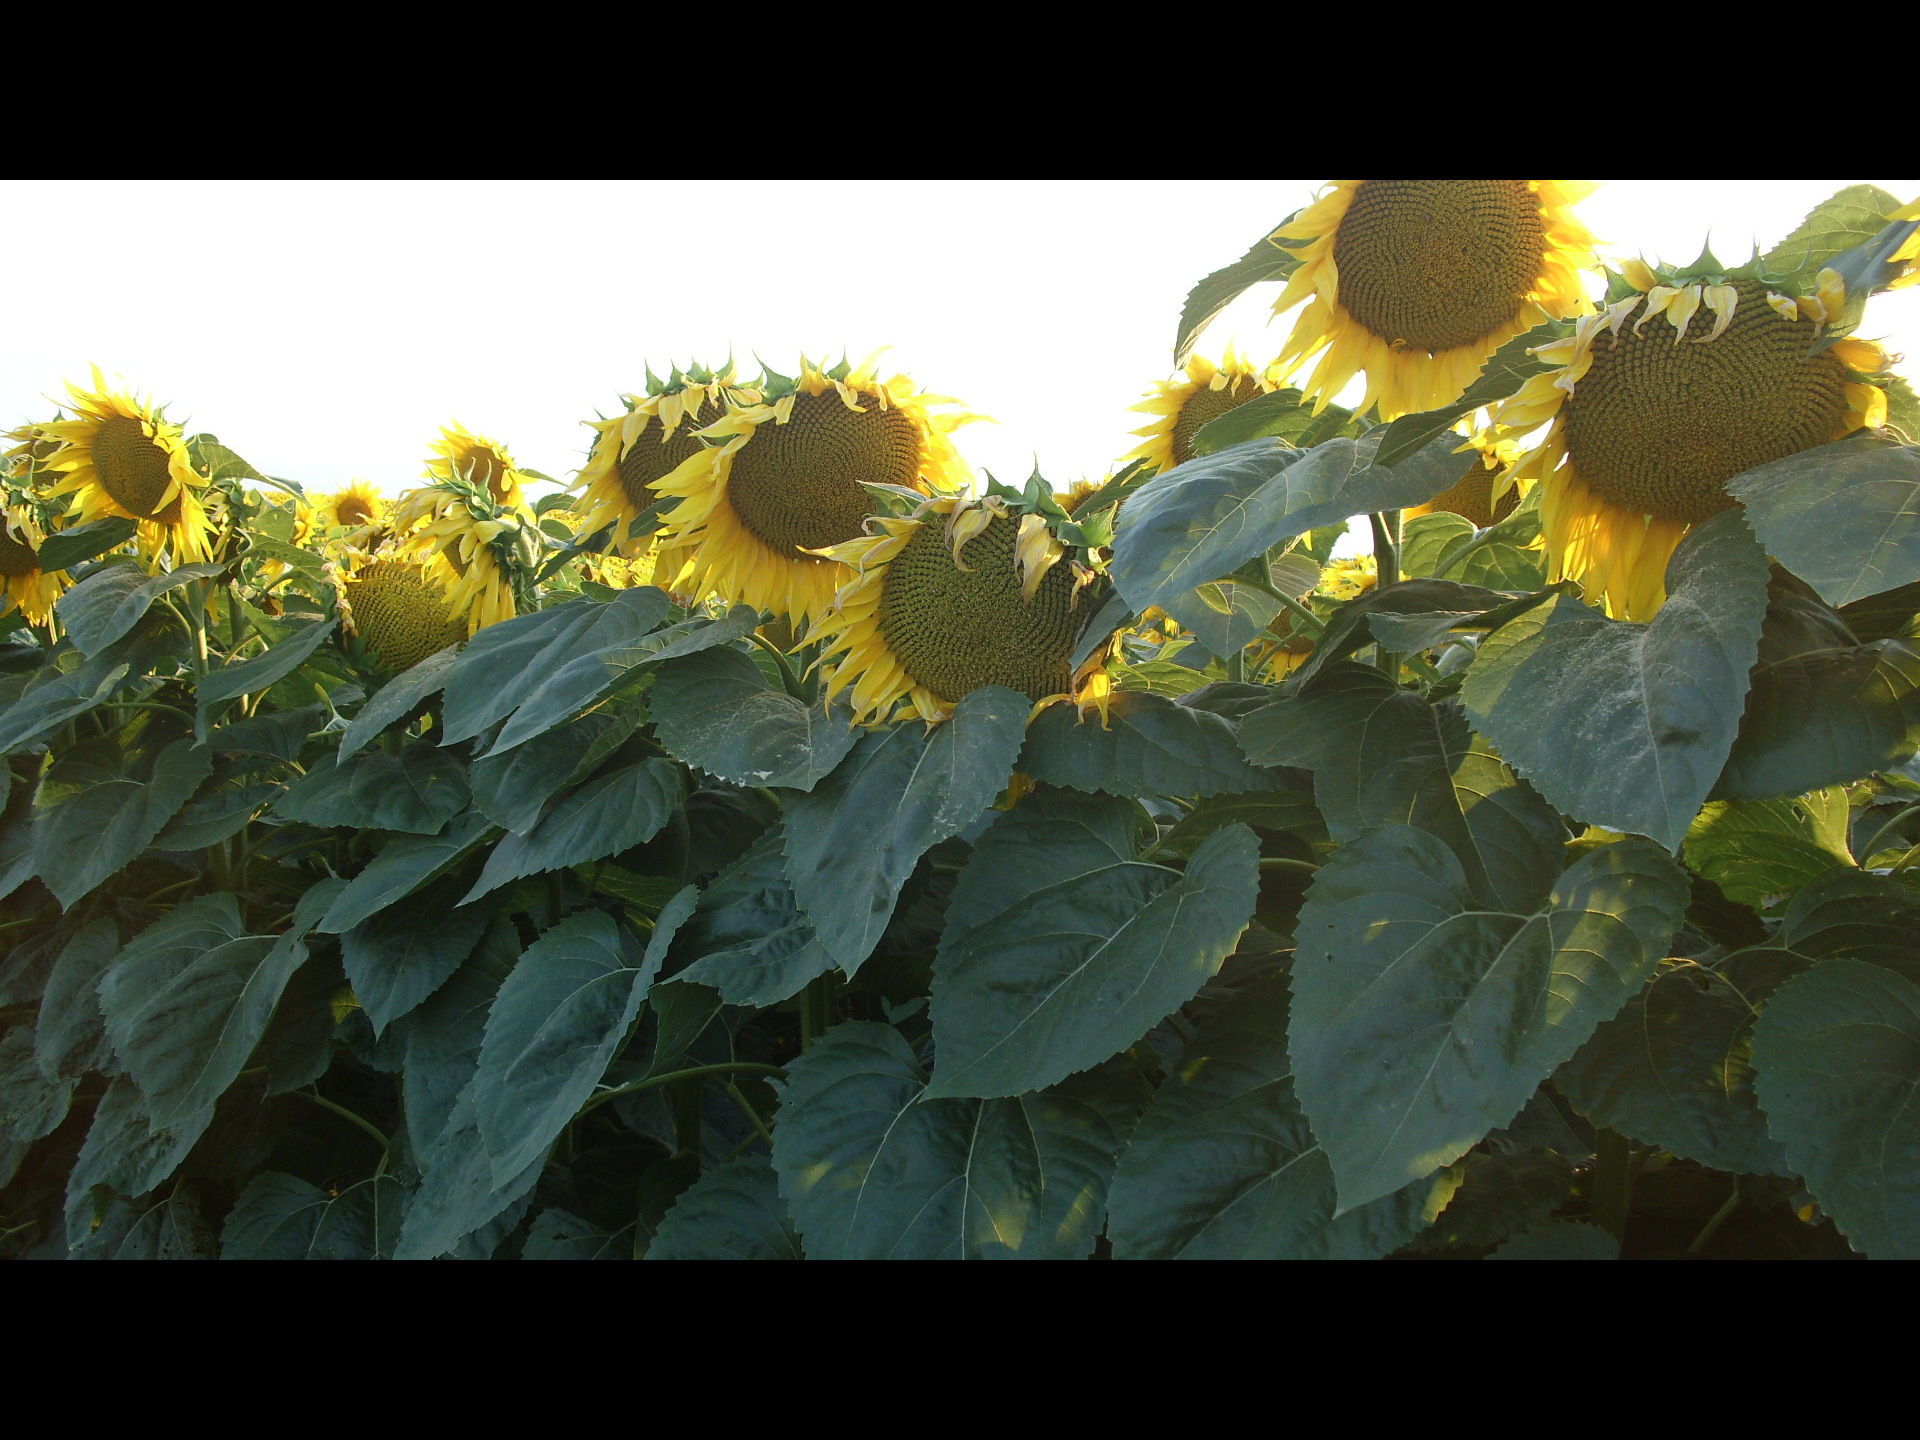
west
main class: Cropland
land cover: Sunflower
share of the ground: > 75 %
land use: Agriculture (excluding fallow land and kitchen gardens)
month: July
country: BG
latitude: 43.7238
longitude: 23.1877
